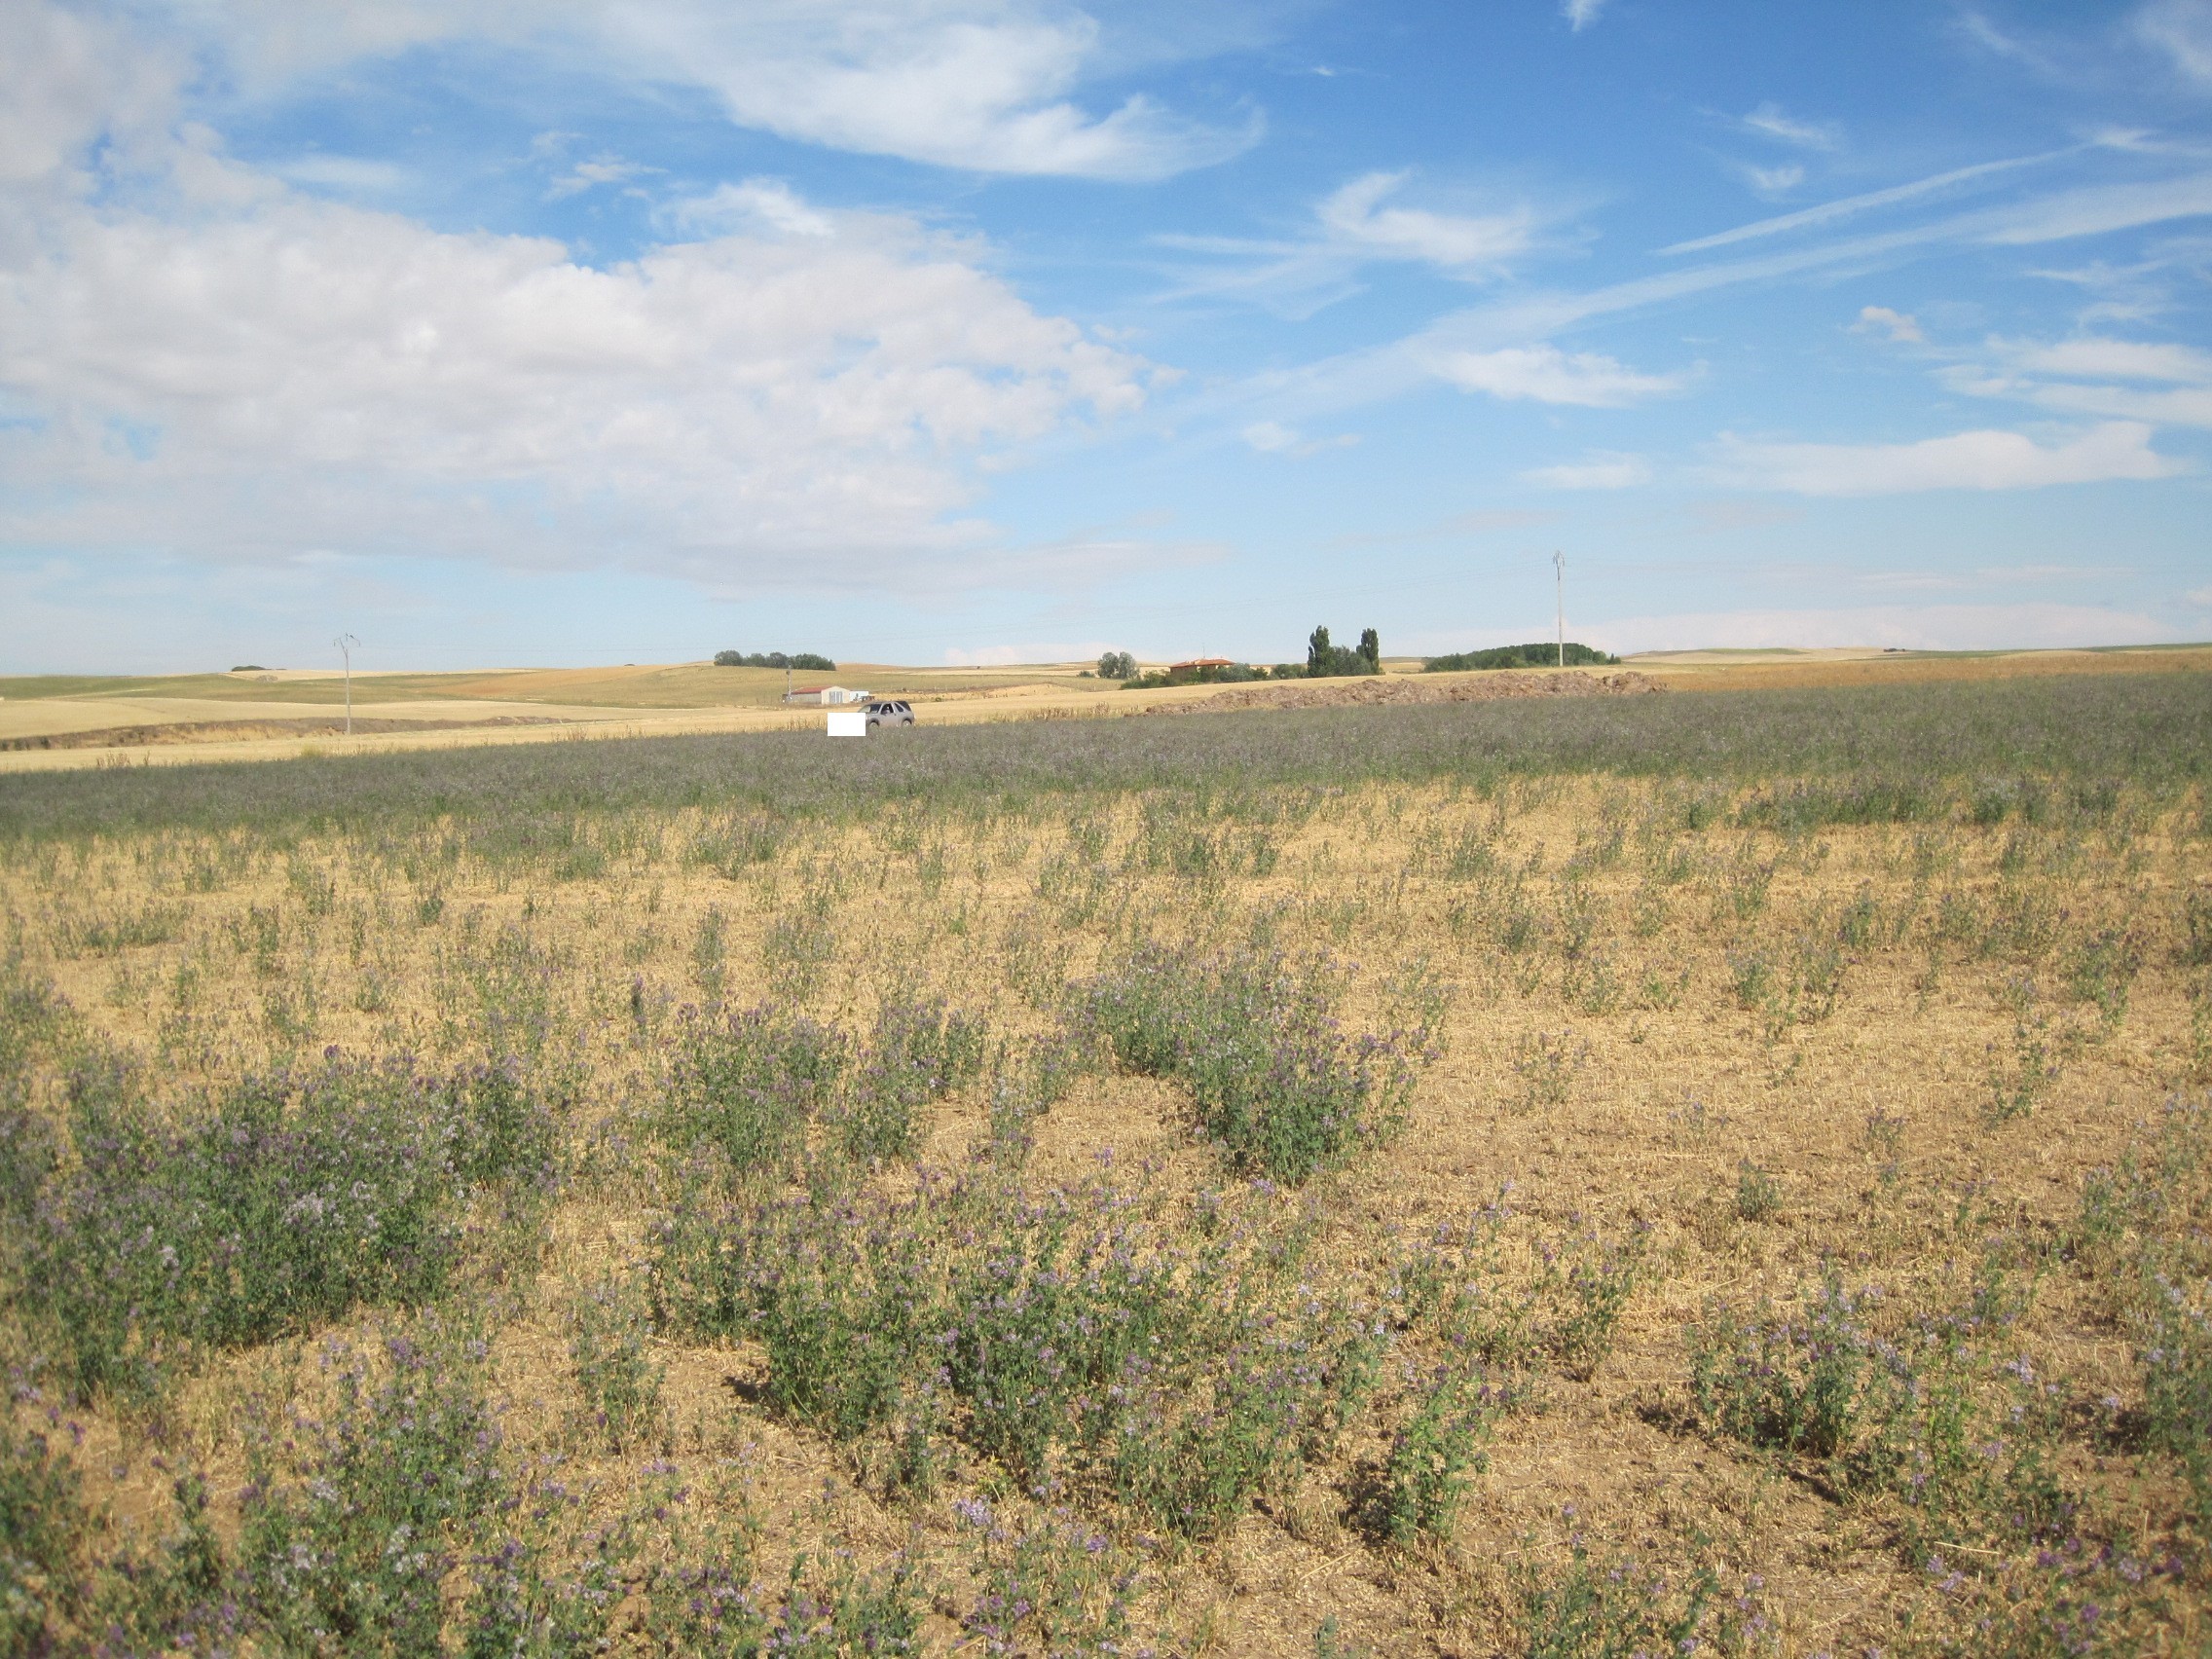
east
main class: Cropland
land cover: Lucerne
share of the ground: > 75 %
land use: Agriculture (excluding fallow land and kitchen gardens)
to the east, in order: Lucerne; Grass margins; Tracks; Grass margins; Common wheat
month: July
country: ES
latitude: 42.0000
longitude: -5.2835
